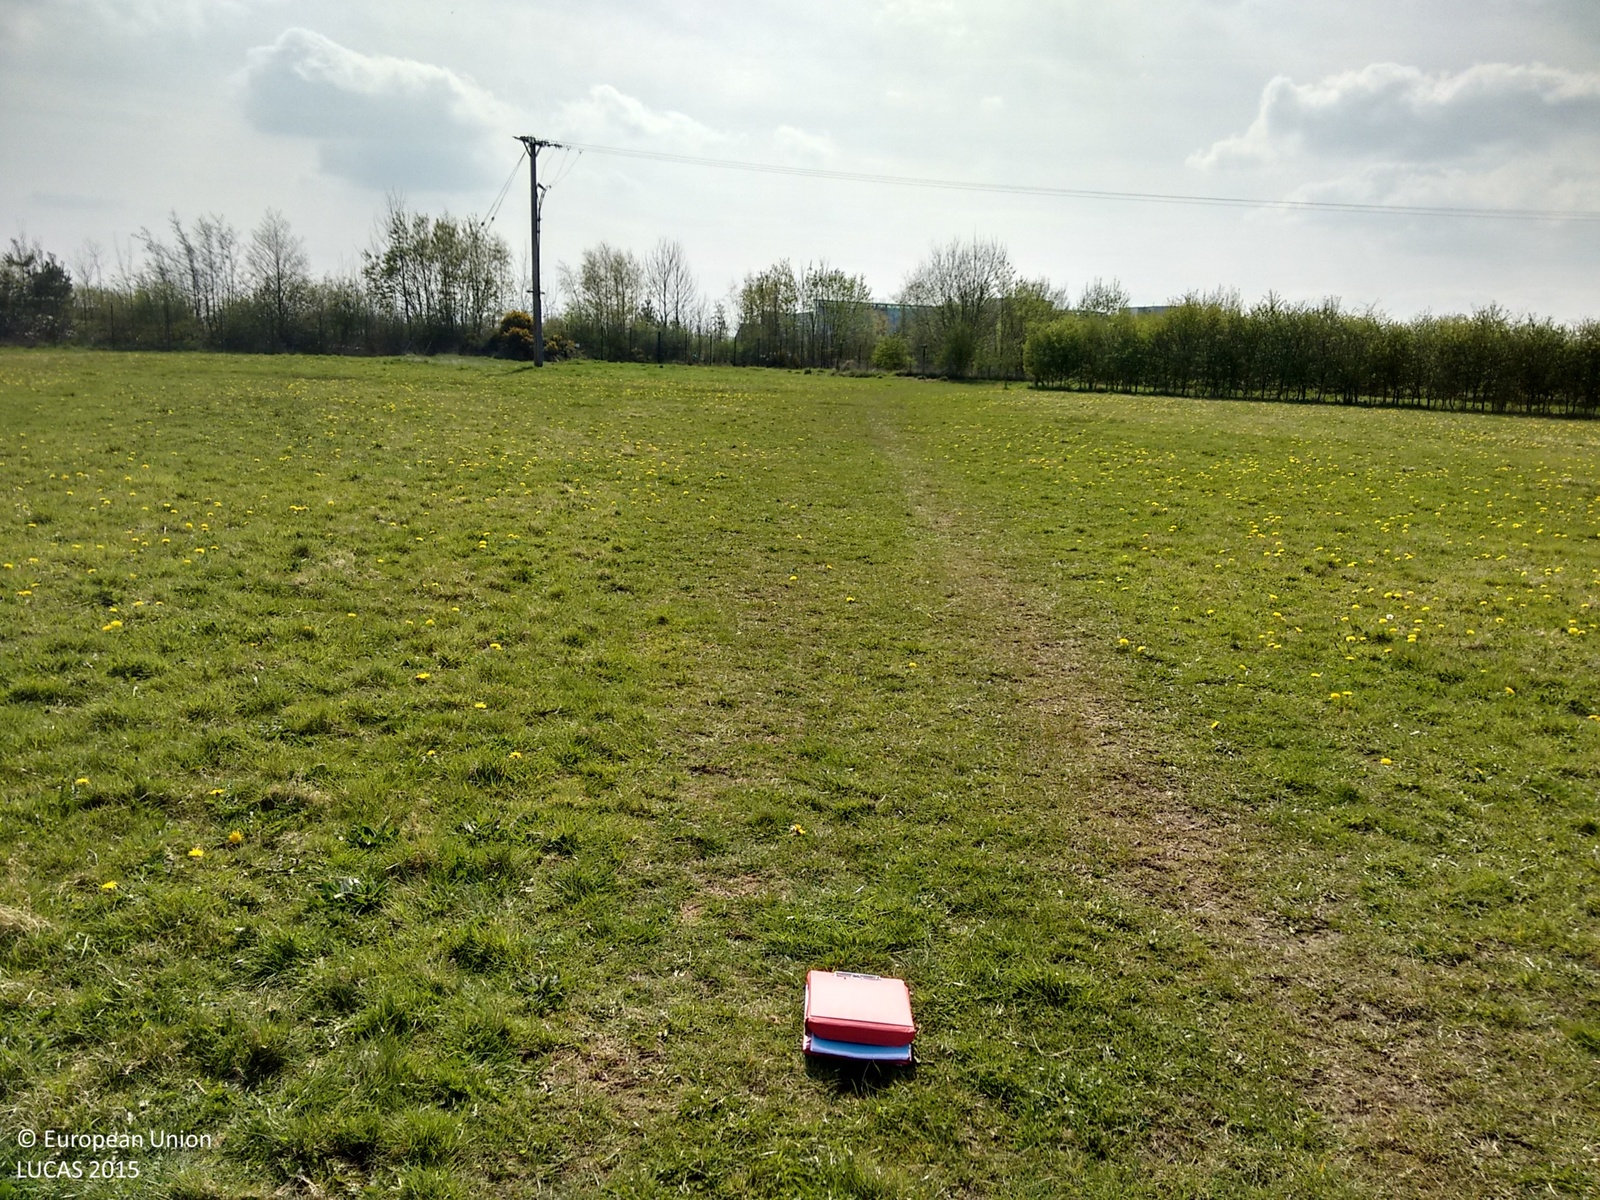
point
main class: Grassland
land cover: Grassland with sparse tree/shrub cover
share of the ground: > 75 %
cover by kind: herbaceous plants 95 %, broadleaved forest trees 5 %
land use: Agriculture (excluding fallow land and kitchen gardens)
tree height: > 5 m
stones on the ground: < 10 %
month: April
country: GB
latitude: 55.0373
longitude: -1.6440
